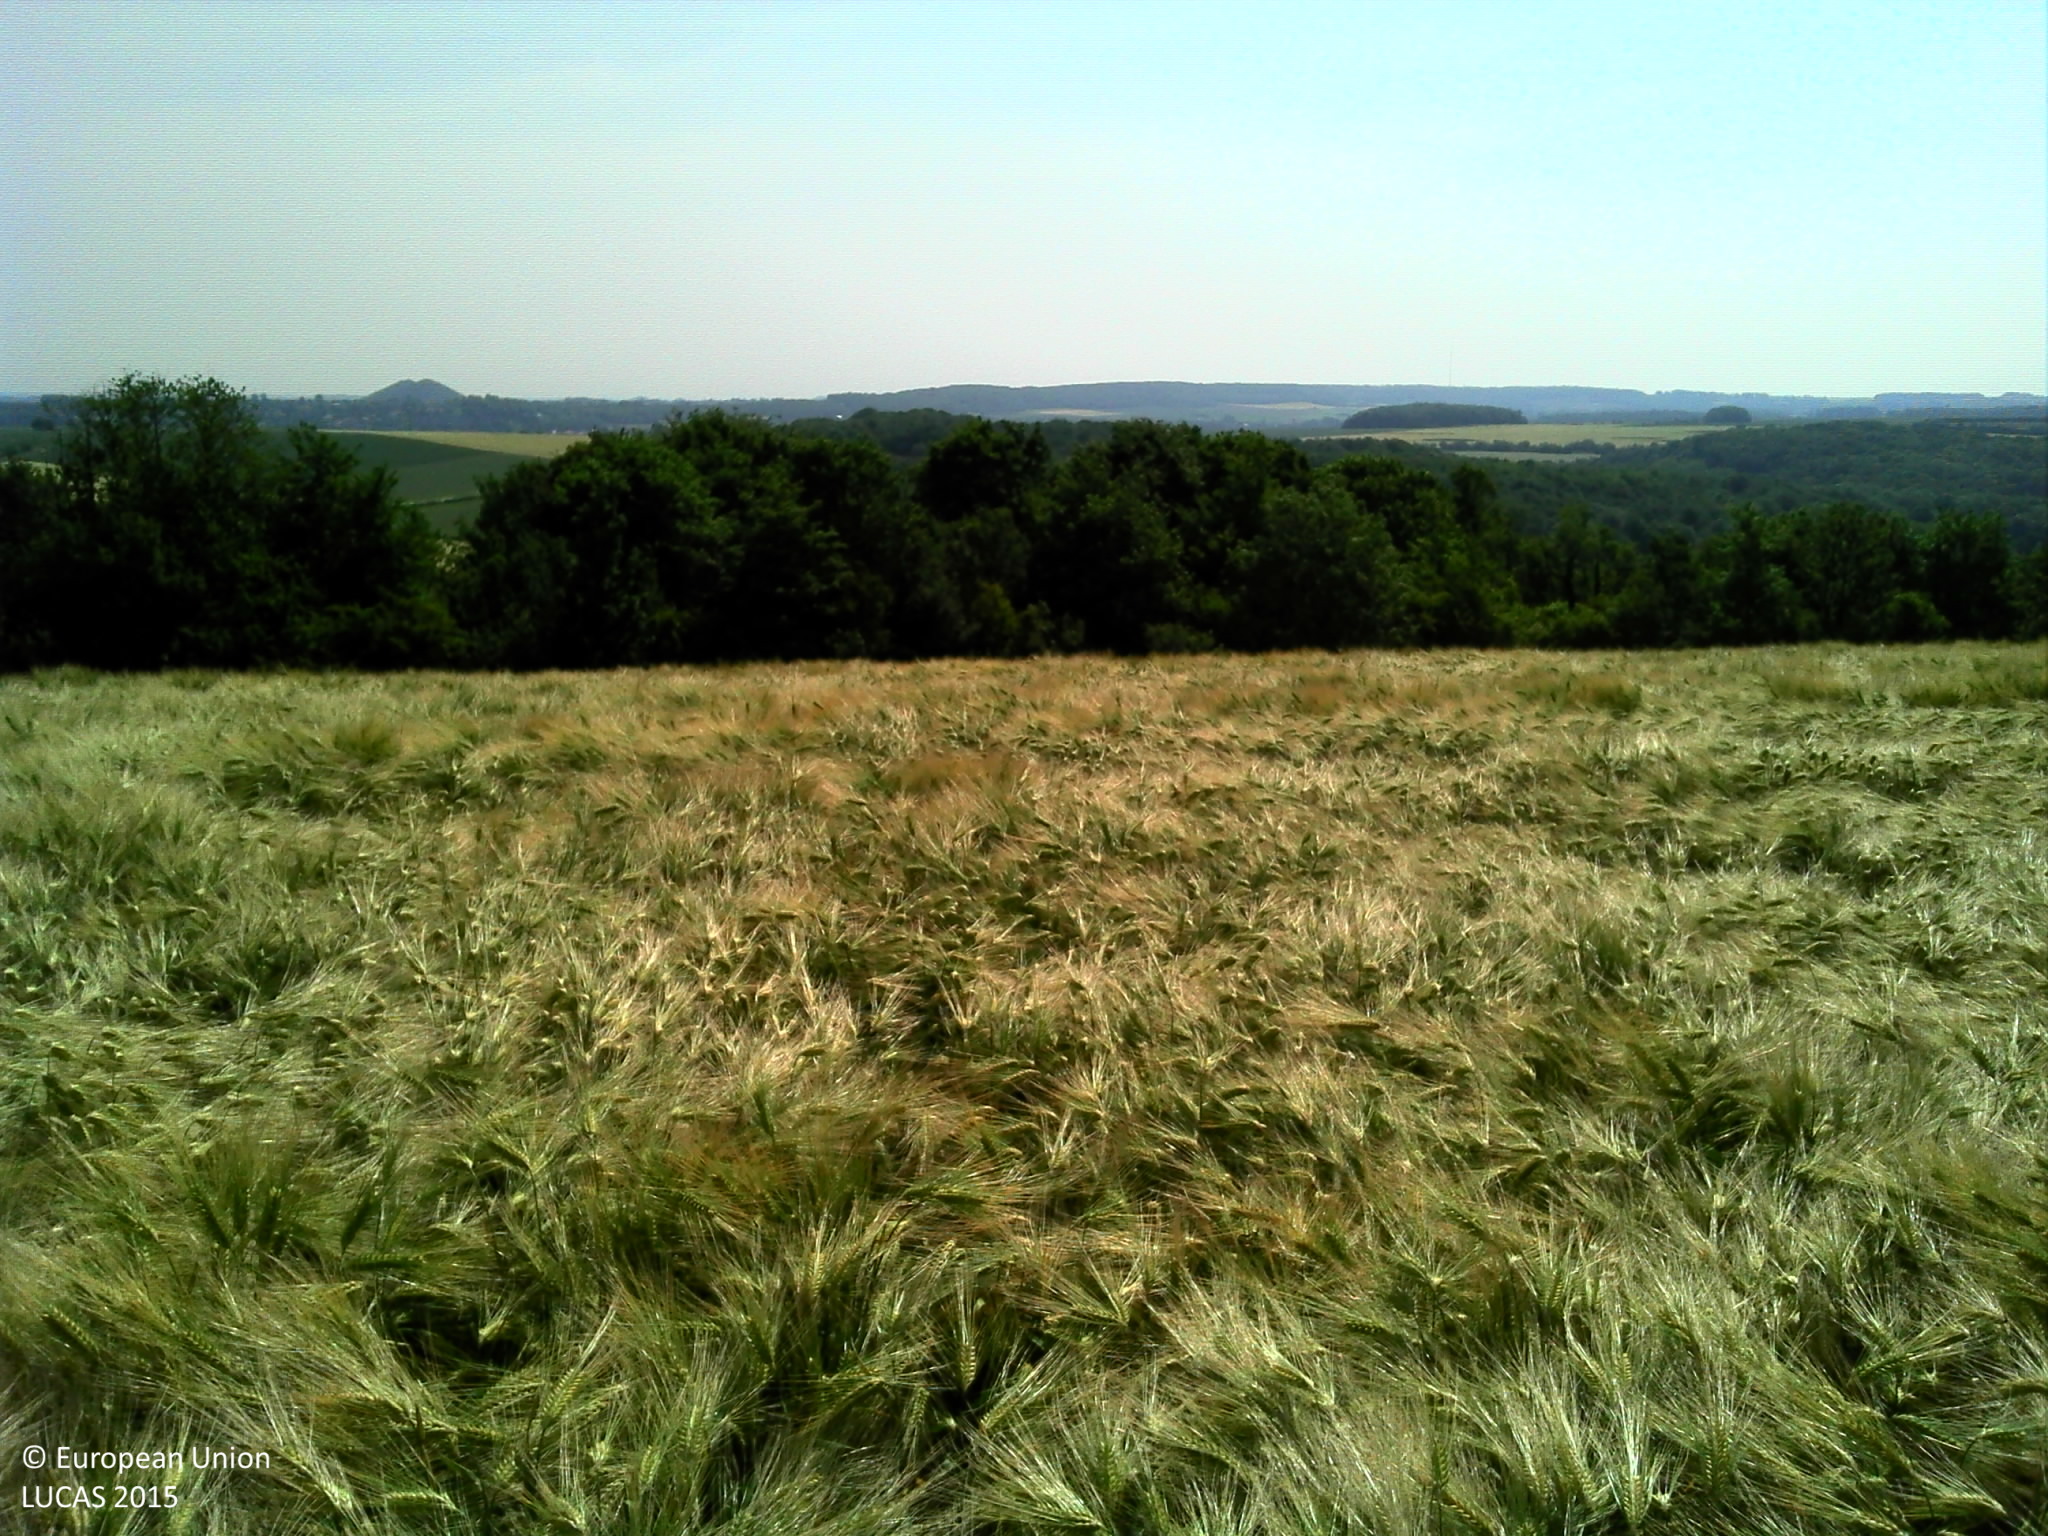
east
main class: Cropland
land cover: Barley
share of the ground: > 75 %
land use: Agriculture (excluding fallow land and kitchen gardens)
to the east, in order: Barley; Grassland without tree/shrub cover; Broadleaved woodland; Tracks; Broadleaved woodland; Tracks; Broadleaved woodland; Tracks; Broadleaved woodland; Grass margins; Barley
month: June
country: FR
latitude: 50.4416
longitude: 2.4821
